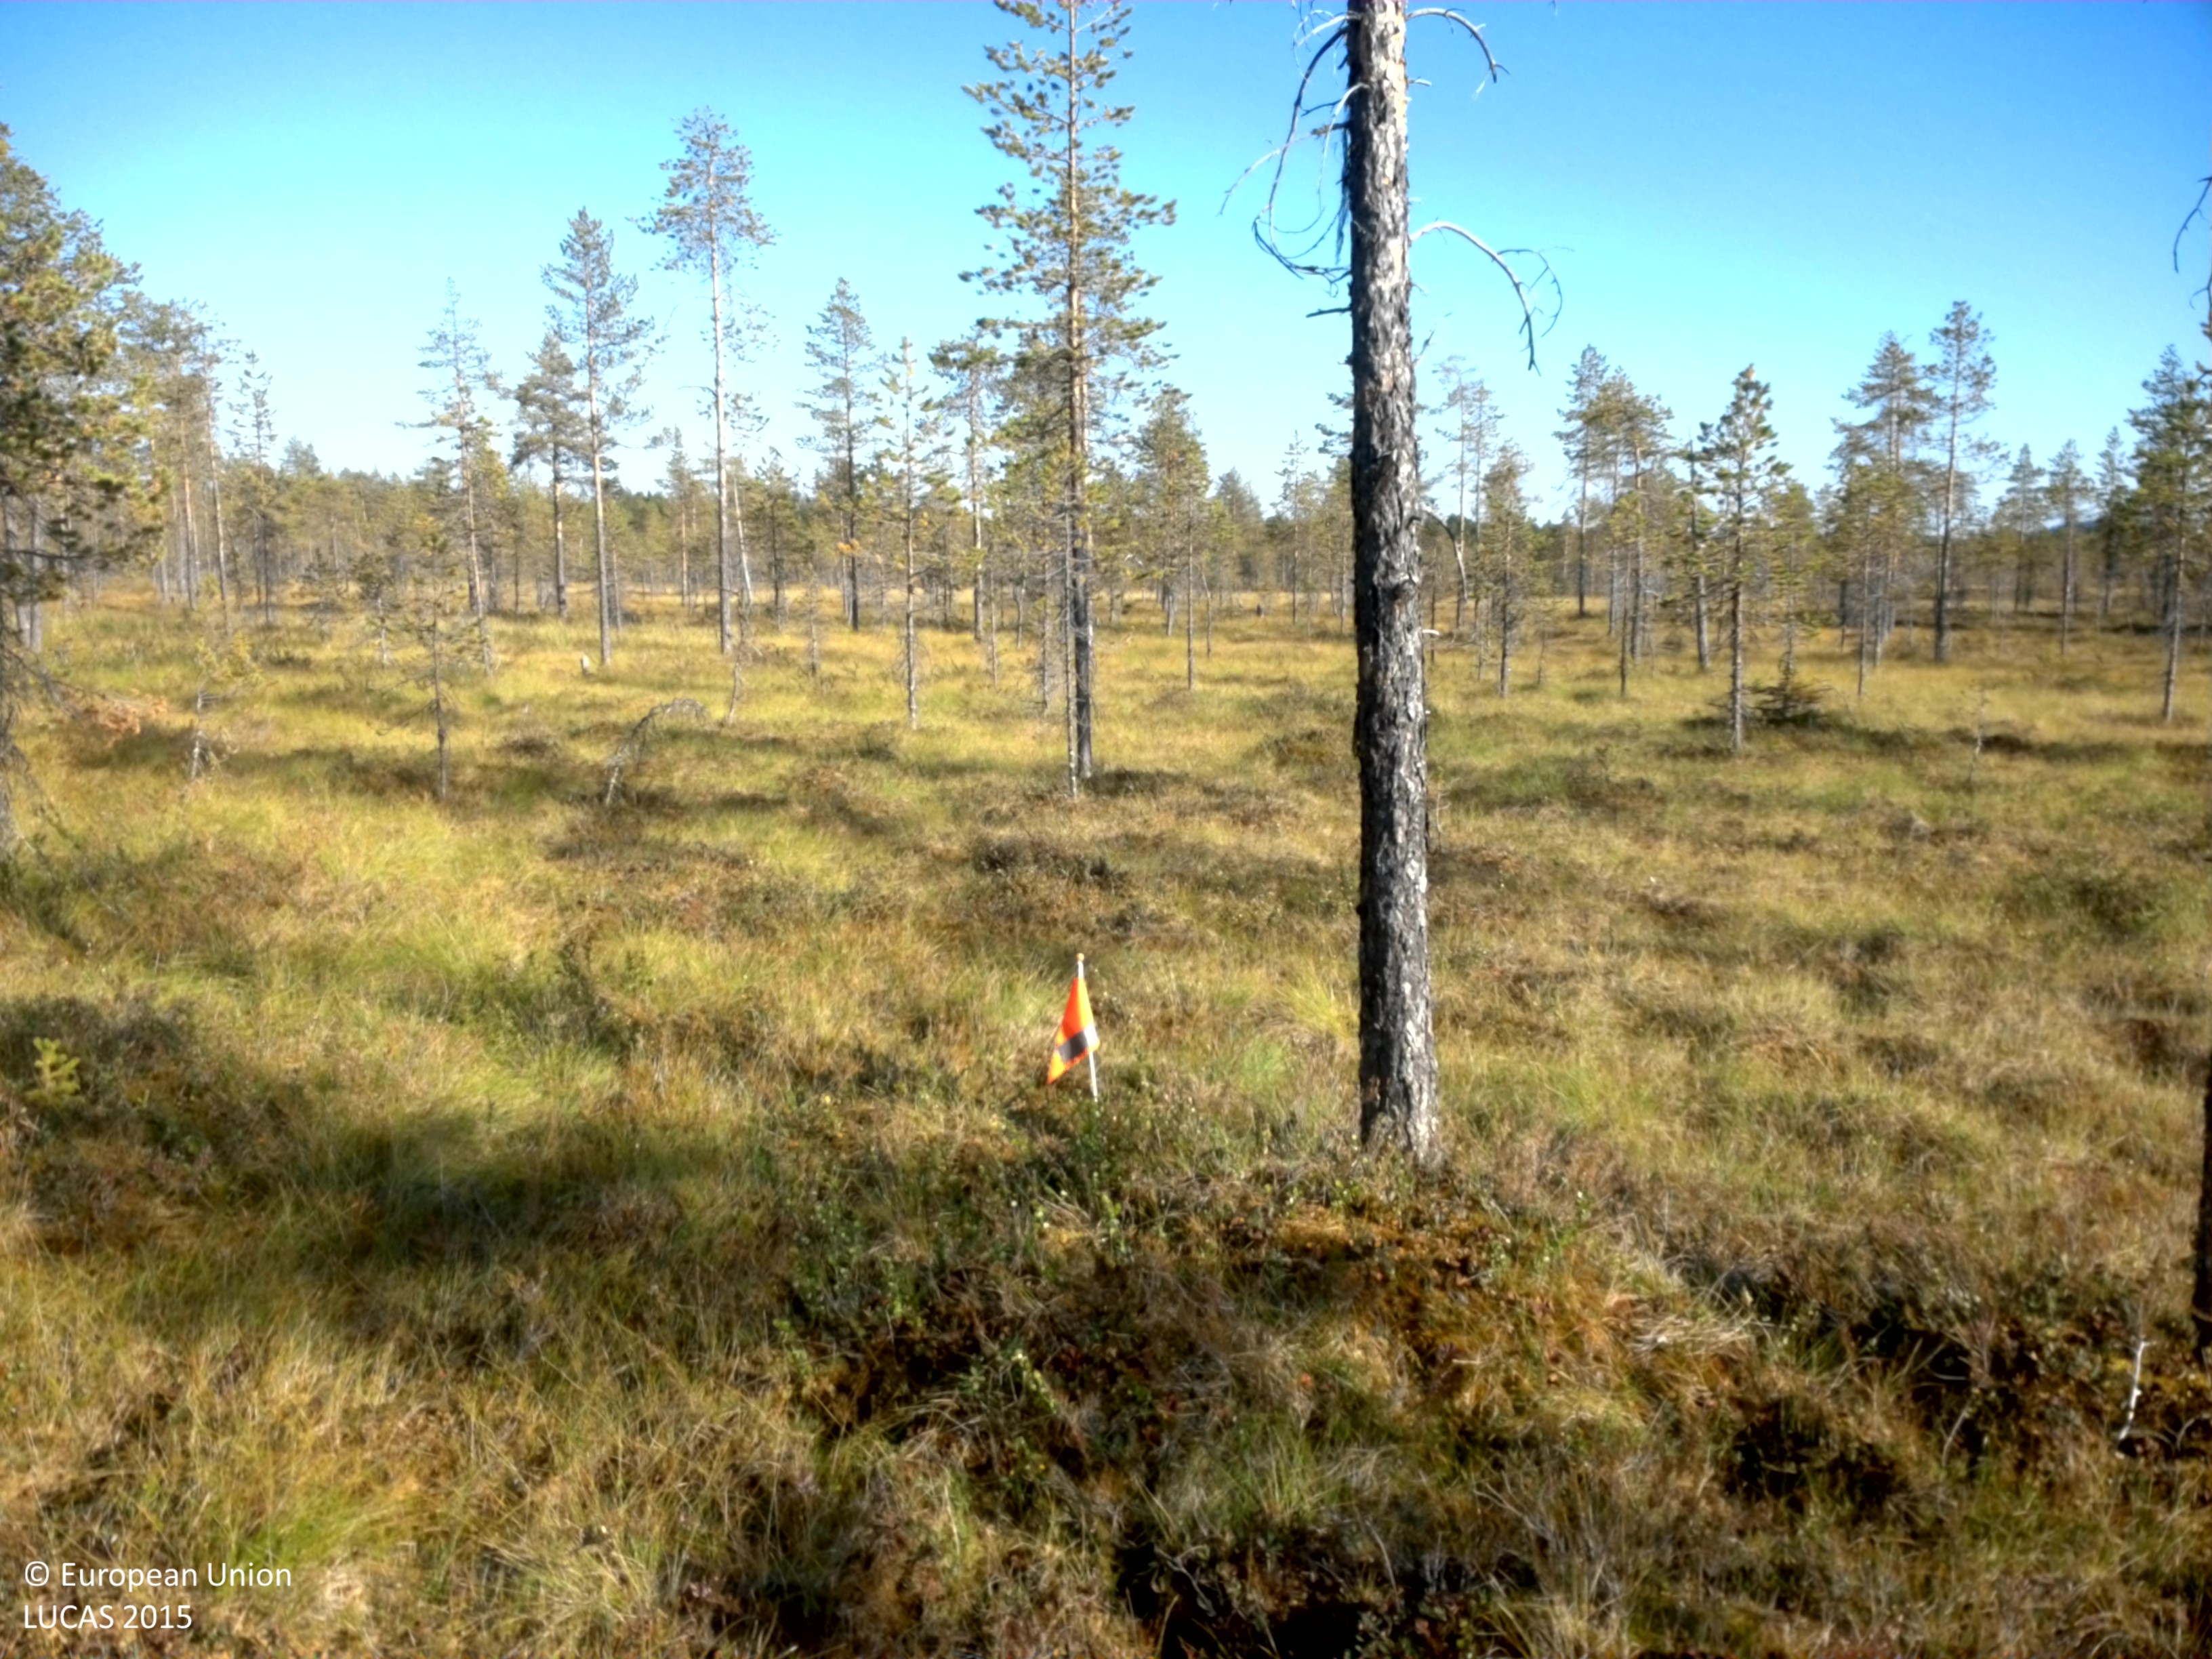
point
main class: Woodland
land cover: Pine dominated coniferous woodland
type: mire and swamp forests
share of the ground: 10 - 25 %
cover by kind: herbaceous plants 35 %, lichens and mosses 35 %, shrubs 20 %, coniferous forest trees 10 %
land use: Semi-natural and natural areas not in use
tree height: > 5 m
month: August
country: SE
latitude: 64.7099
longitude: 16.7007
